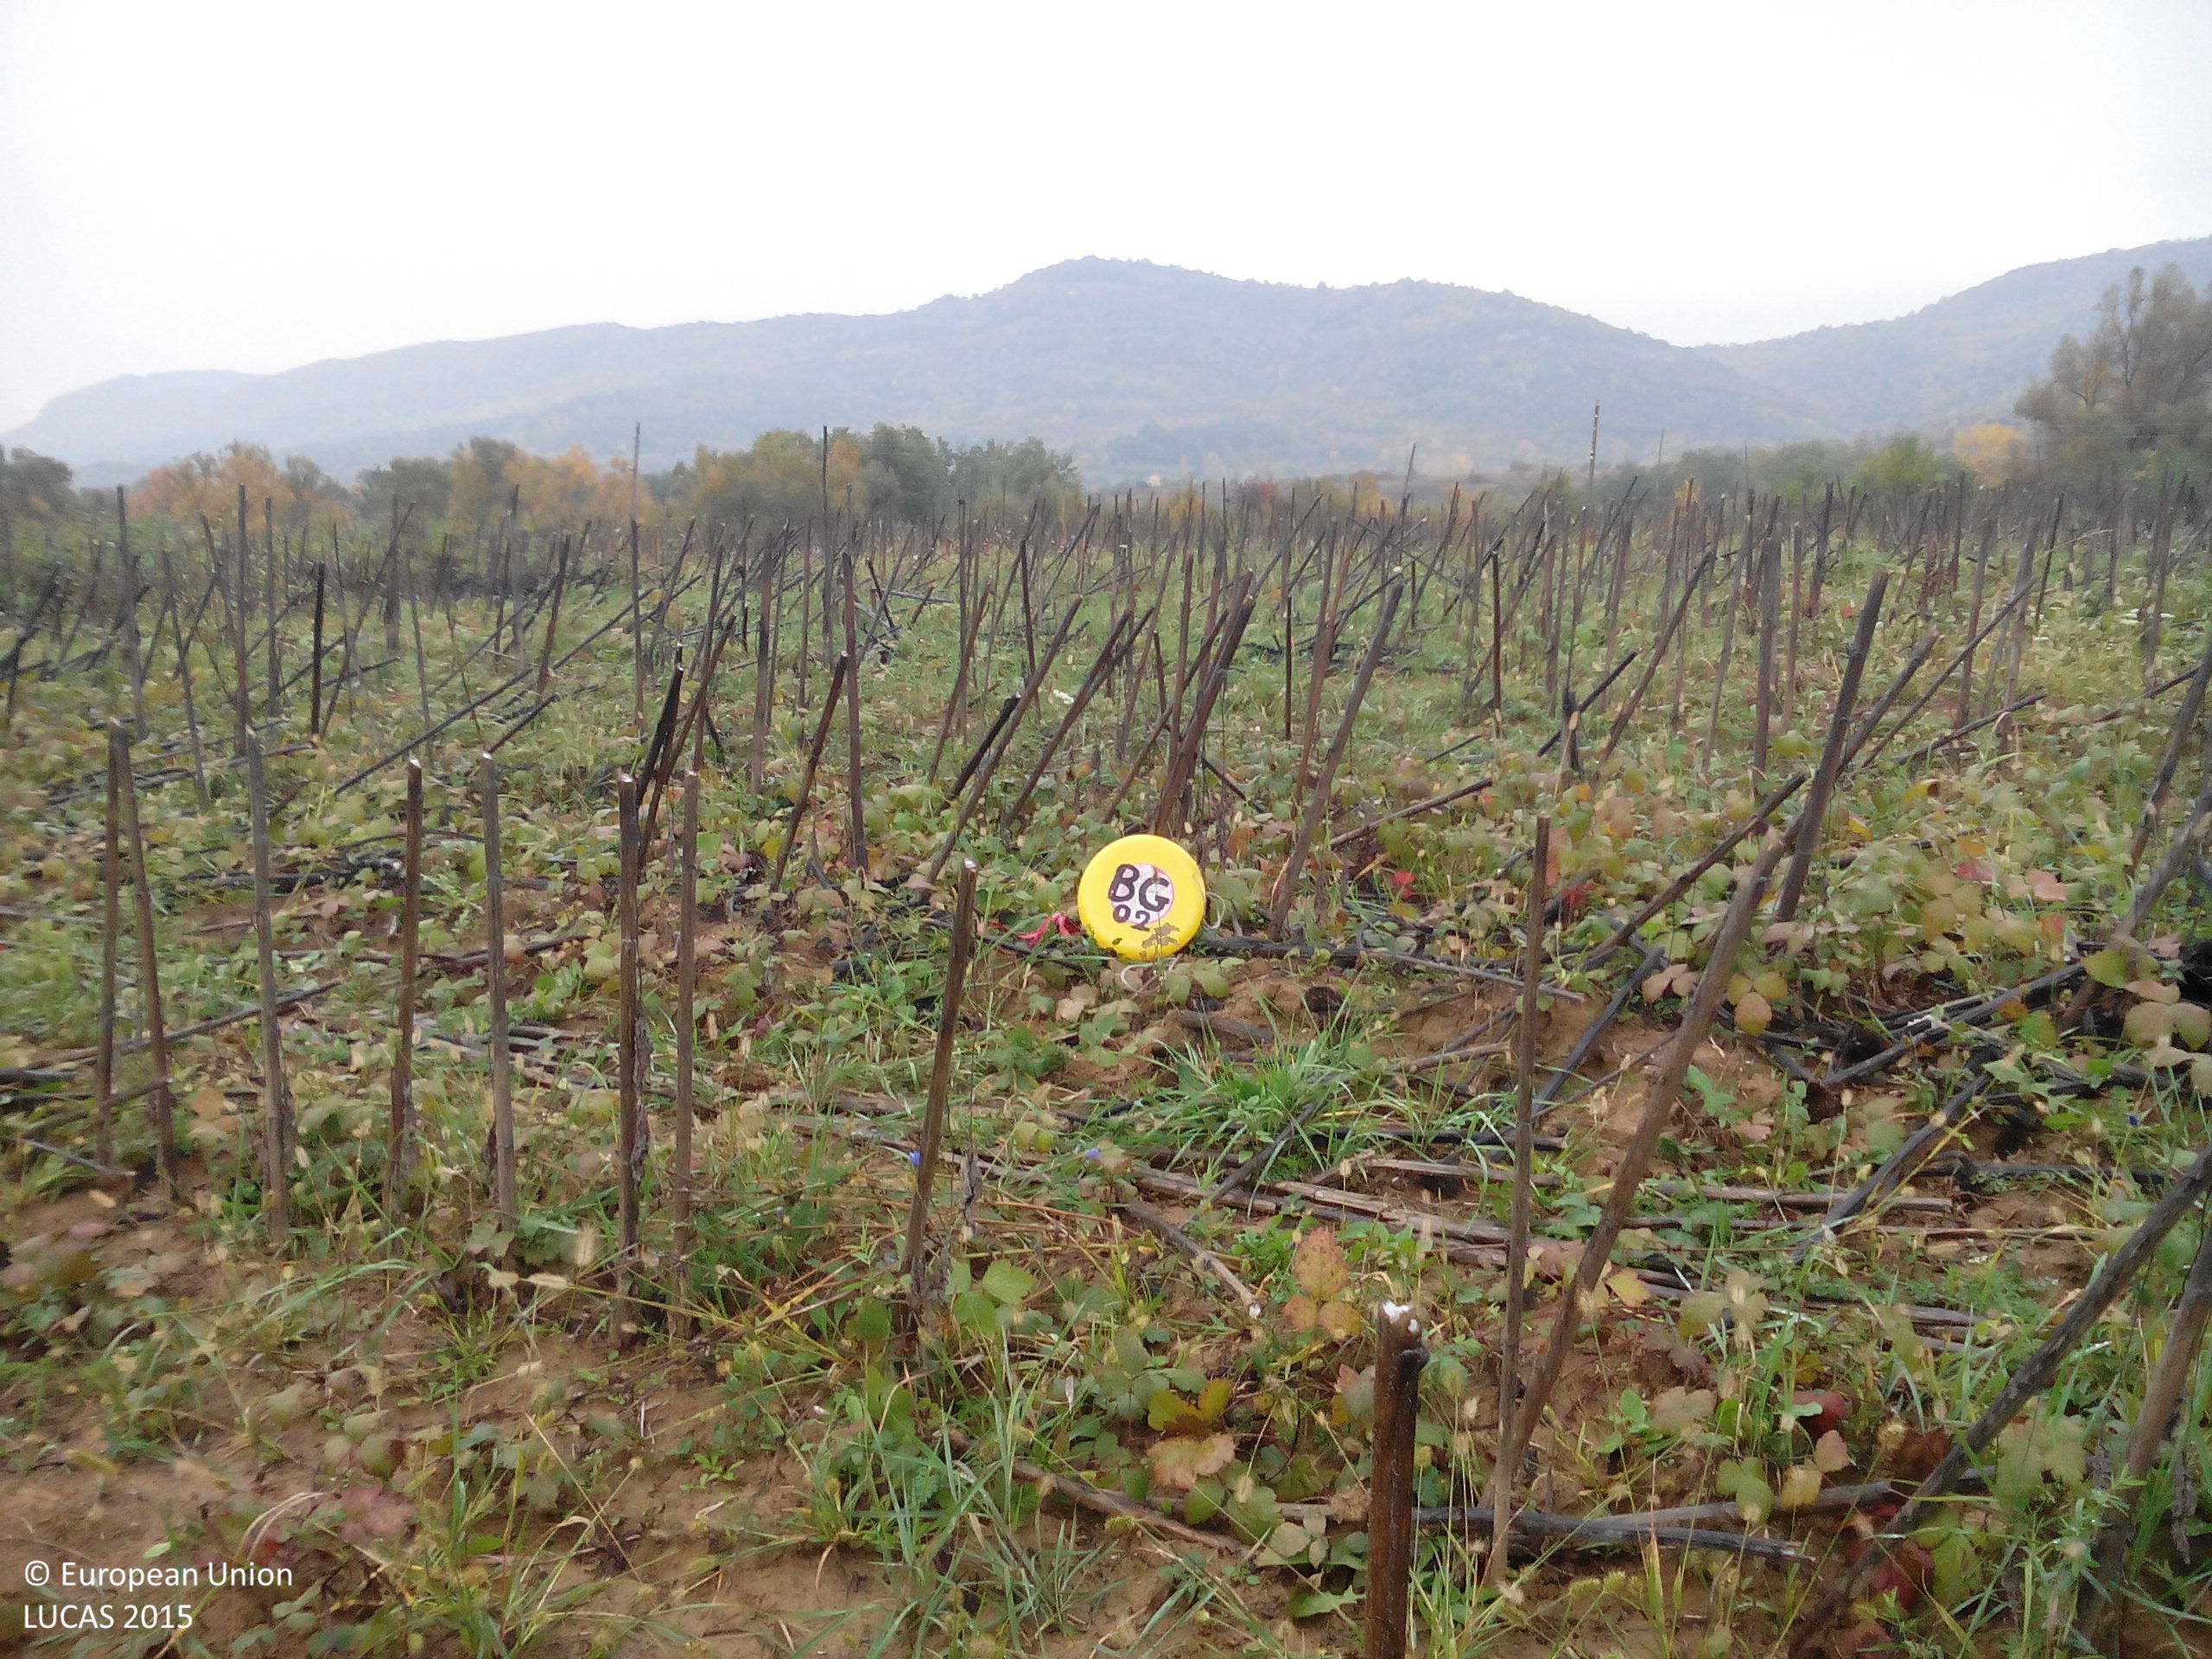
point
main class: Cropland
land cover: Sunflower
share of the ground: 10 - 25 %
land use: Agriculture (excluding fallow land and kitchen gardens)
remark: Harvested field
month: October
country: BG
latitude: 43.0831
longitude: 24.0150
